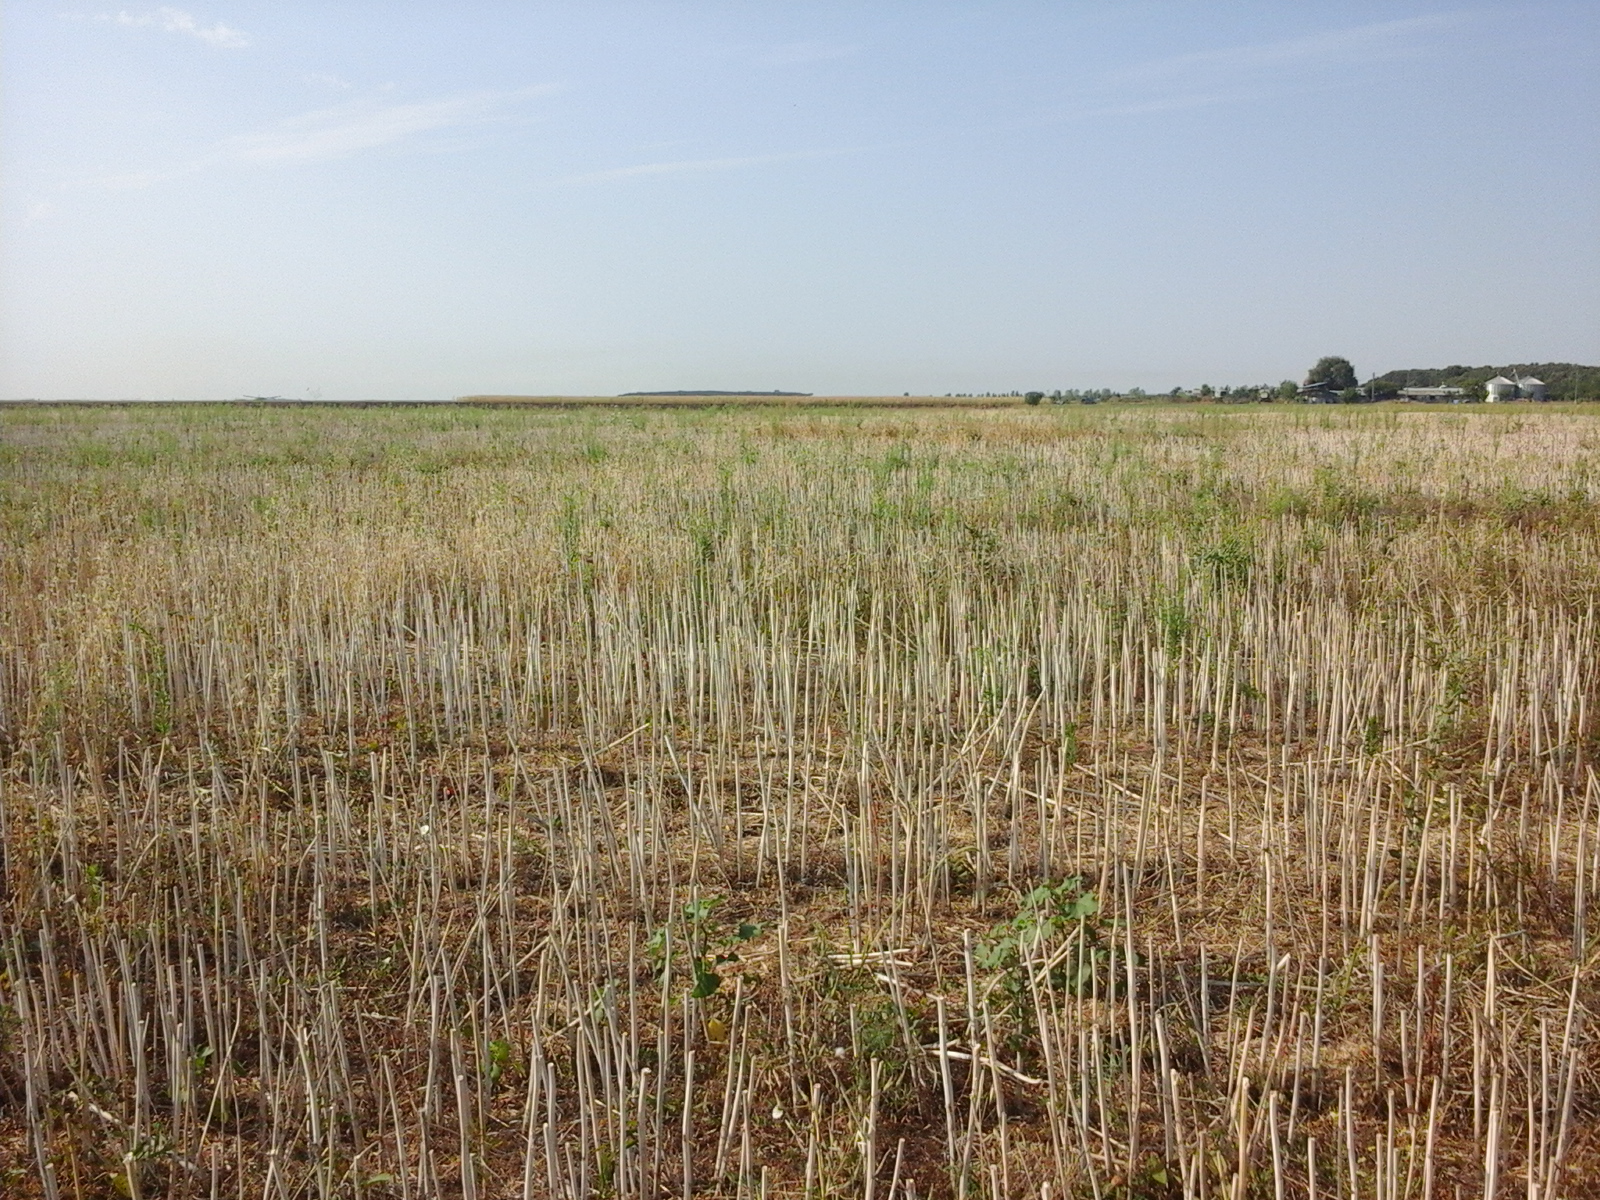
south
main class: Cropland
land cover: Rape and turnip rape
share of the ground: > 75 %
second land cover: Spontaneously vegetated surfaces
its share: 50 - 75 %
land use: Agriculture (excluding fallow land and kitchen gardens)
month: August
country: RO
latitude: 44.1439
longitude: 23.7431
